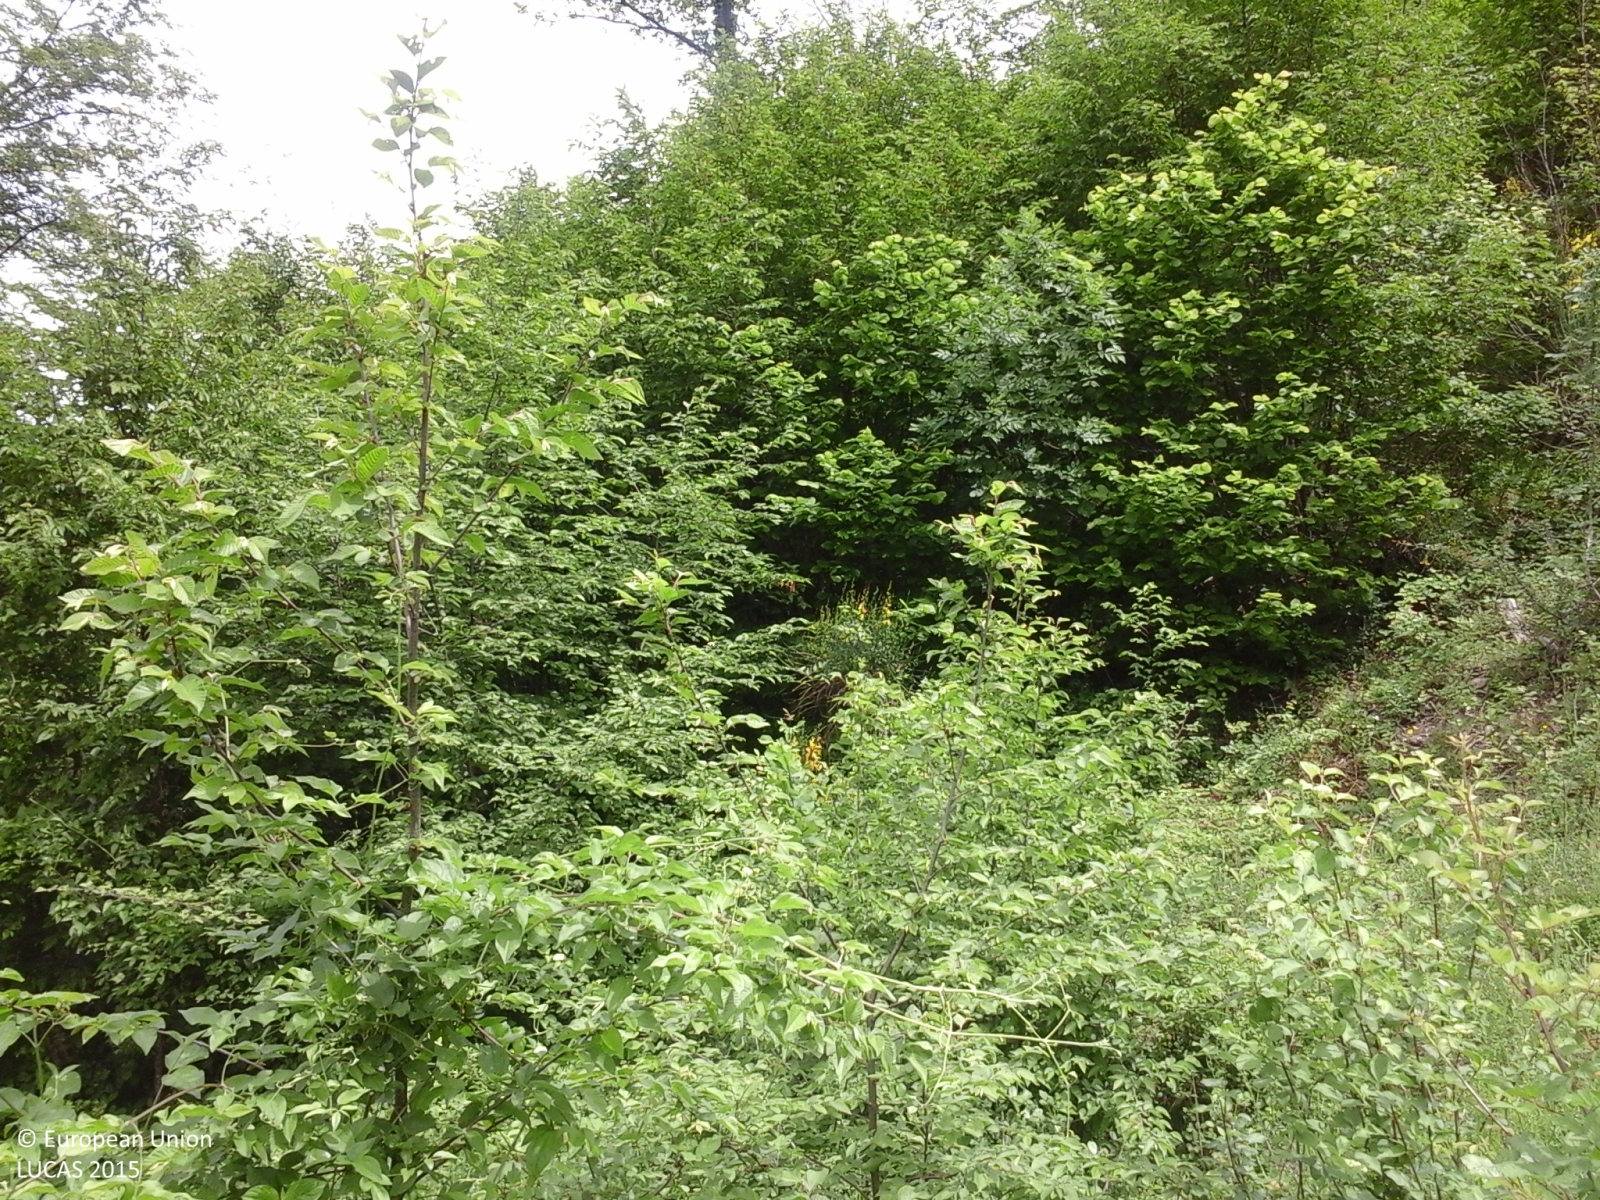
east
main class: Grassland
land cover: Grassland with sparse tree/shrub cover
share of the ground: > 75 %
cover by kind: herbaceous plants 85 %, shrubs 10 %, broadleaved forest trees 5 %
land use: Semi-natural and natural areas not in use
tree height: < 5 m
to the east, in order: Grassland with sparse tree/shrub cover; Broadleaved woodland
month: May
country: IT
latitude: 44.0191
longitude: 11.1822
